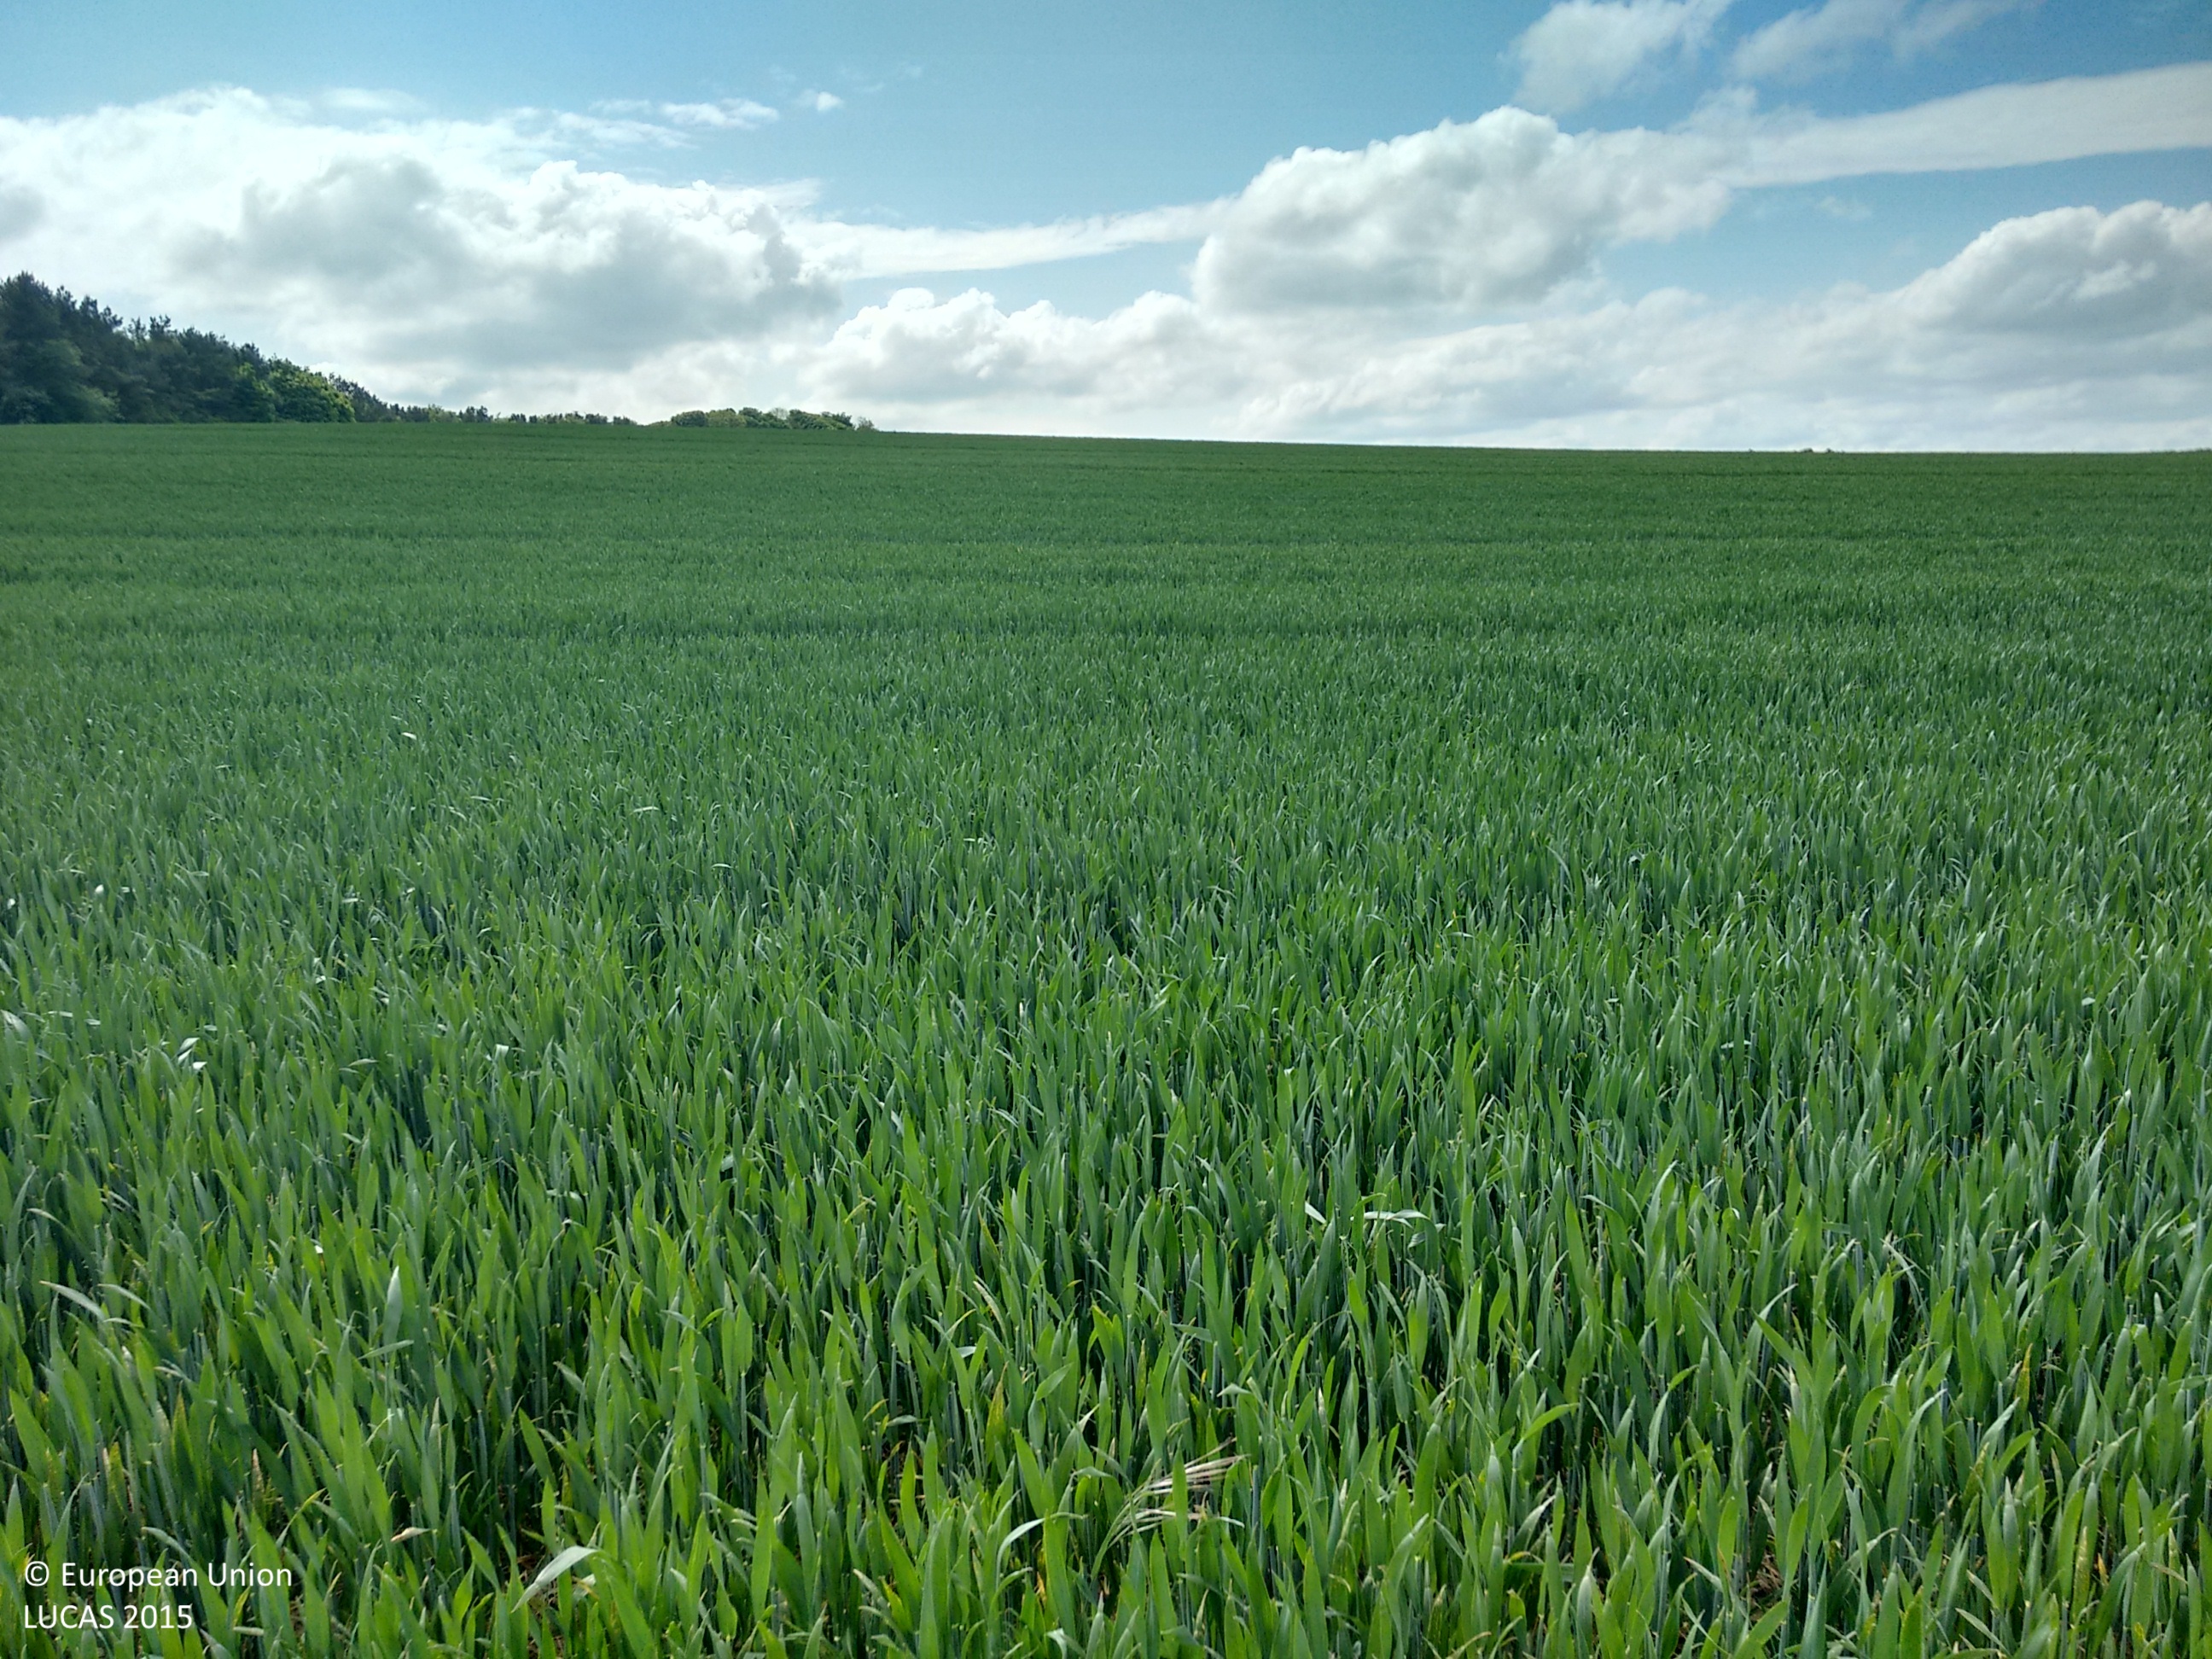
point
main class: Cropland
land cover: Common wheat
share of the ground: > 75 %
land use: Agriculture (excluding fallow land and kitchen gardens)
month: June
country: GB
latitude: 55.4383
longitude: -1.6336
